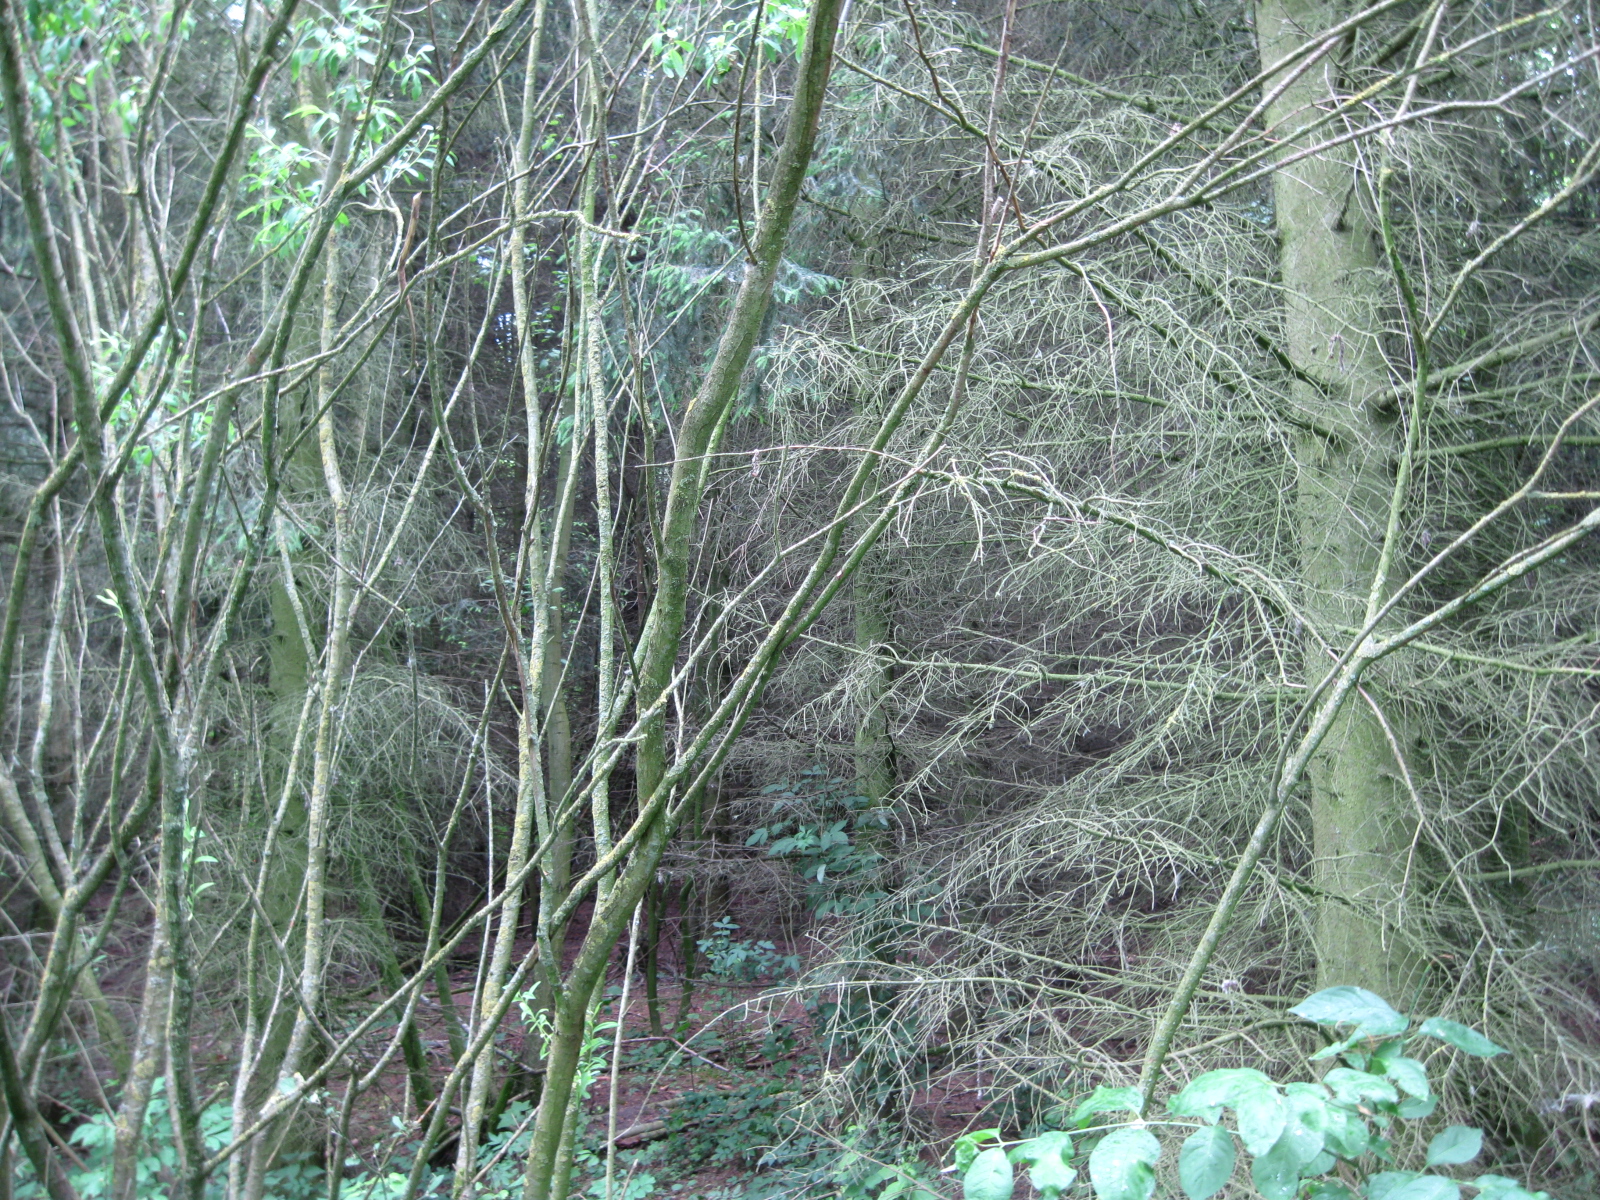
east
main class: Woodland
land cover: Broadleaved woodland
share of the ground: > 75 %
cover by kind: broadleaved forest trees 80 %, herbaceous plants 10 %, coniferous forest trees 5 %, shrubs 5 %
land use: Forestry
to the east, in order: Ditches and canals; Spruce dominated coniferous woodland; Spruce dominated mixed woodland; Ditches and canals; Spruce dominated mixed woodland
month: June
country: LT
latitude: 55.2914
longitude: 24.1235
